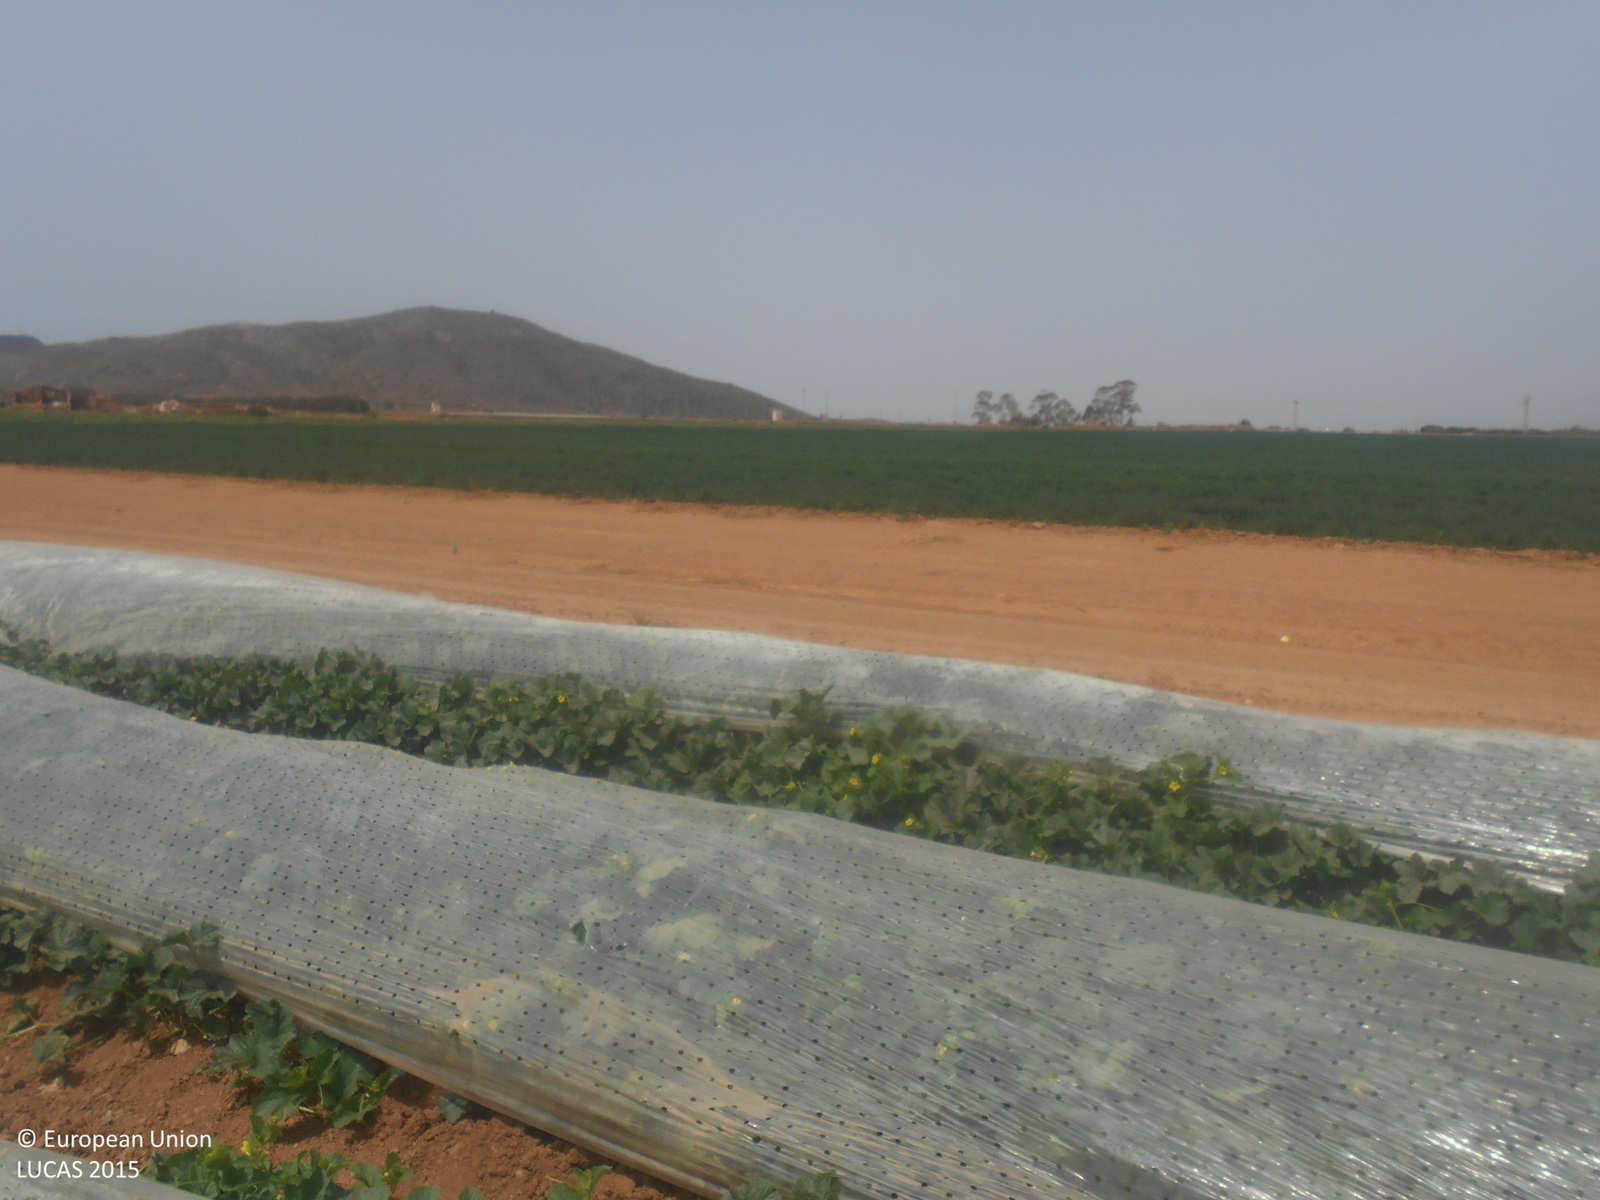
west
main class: Cropland
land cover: Other fresh vegetables
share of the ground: > 75 %
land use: Agriculture (excluding fallow land and kitchen gardens)
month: May
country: ES
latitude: 37.6423
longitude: -0.8014
